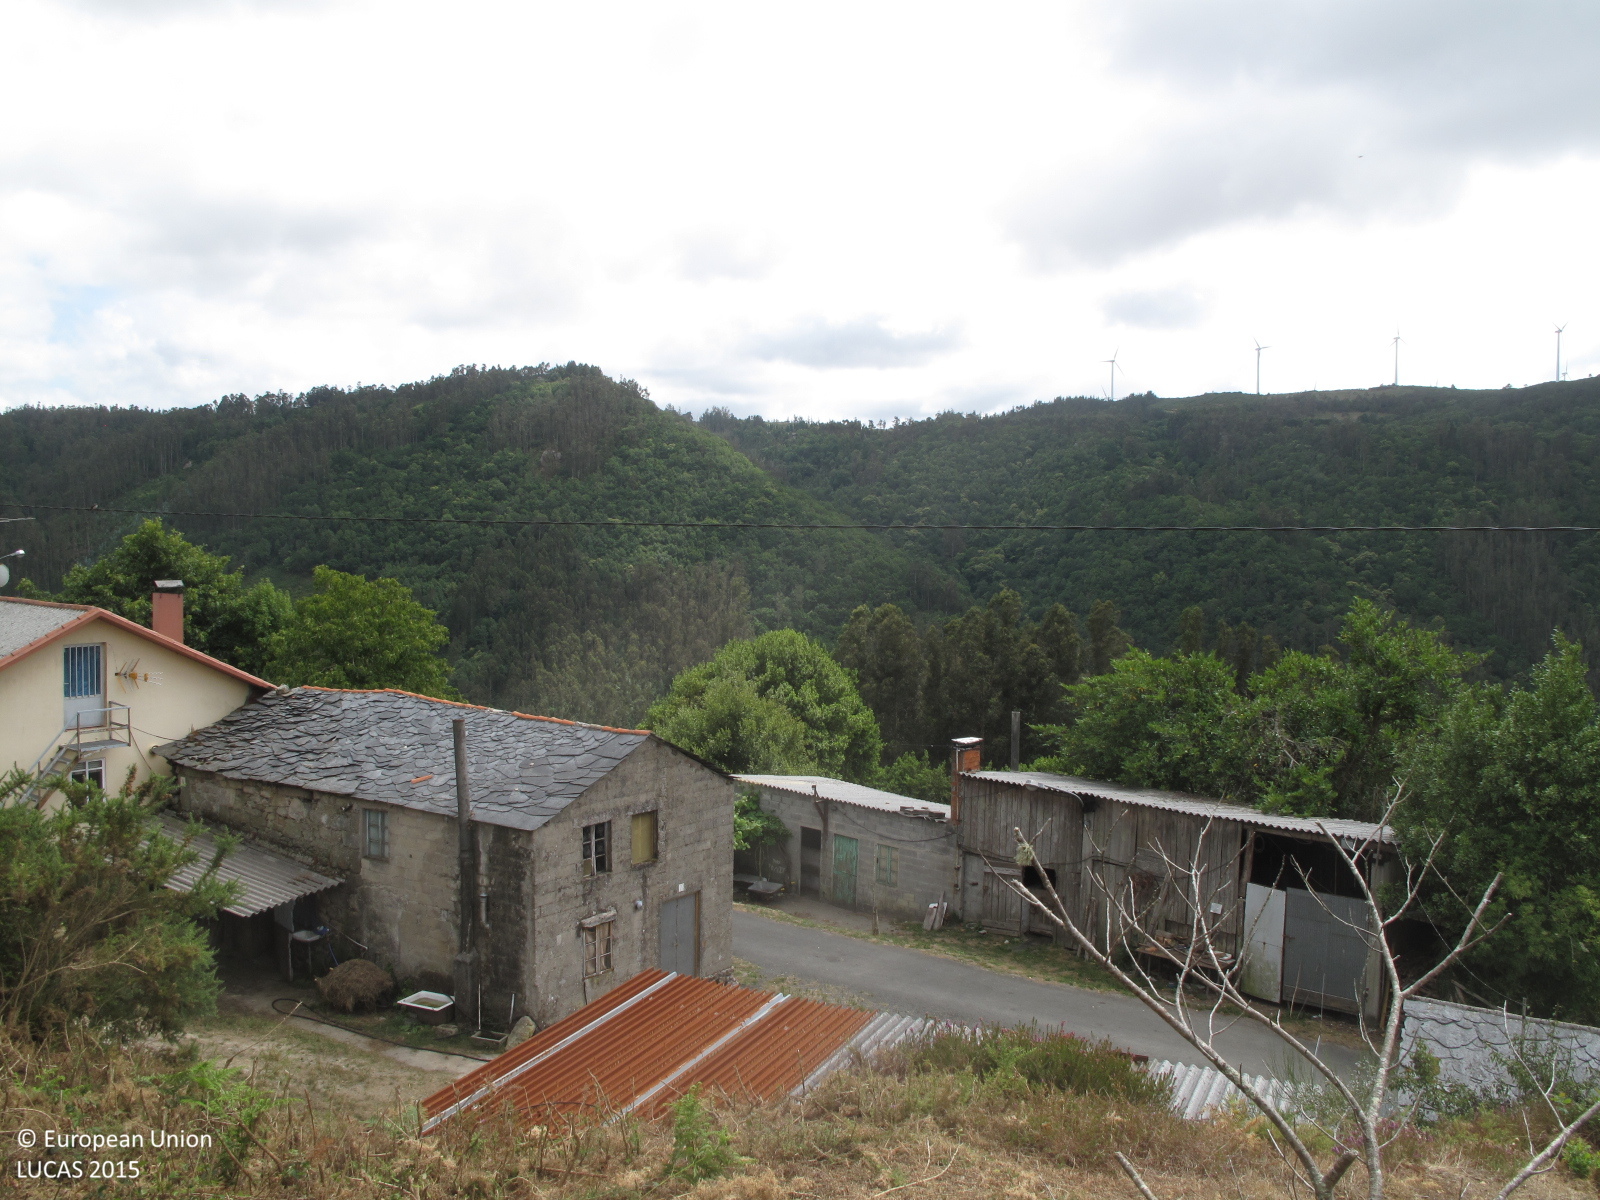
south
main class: Shrubland
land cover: Shrubland with sparse tree cover
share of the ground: 10 - 25 %
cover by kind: herbaceous plants 80 %, shrubs 10 %, broadleaved forest trees 5 %, unconsolidated bare surface 5 %
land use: Semi-natural and natural areas not in use
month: July
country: ES
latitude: 43.4956
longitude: -8.0157
